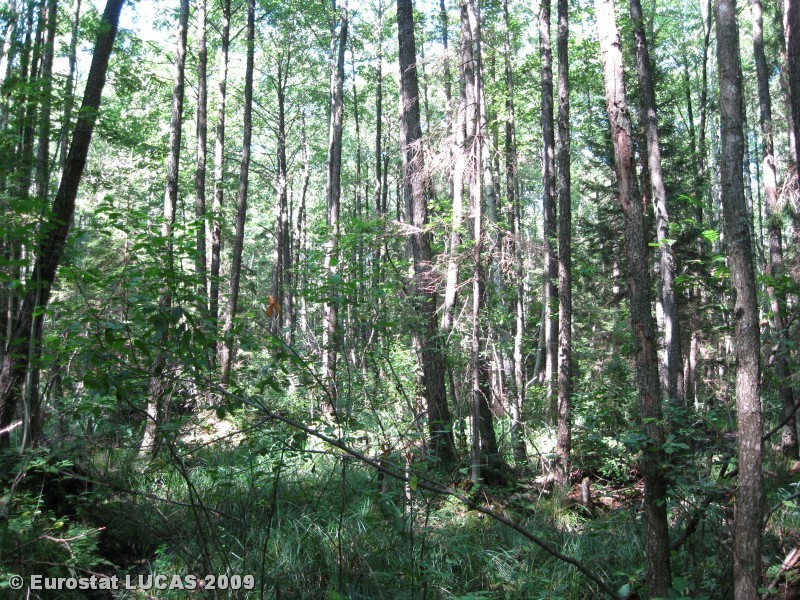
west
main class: Woodland
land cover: Broadleaved woodland
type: non-riverine alder, birch or aspen forest
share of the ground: > 75 %
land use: Forestry
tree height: > 5 m
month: August
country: LT
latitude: 54.9031
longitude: 23.5087
